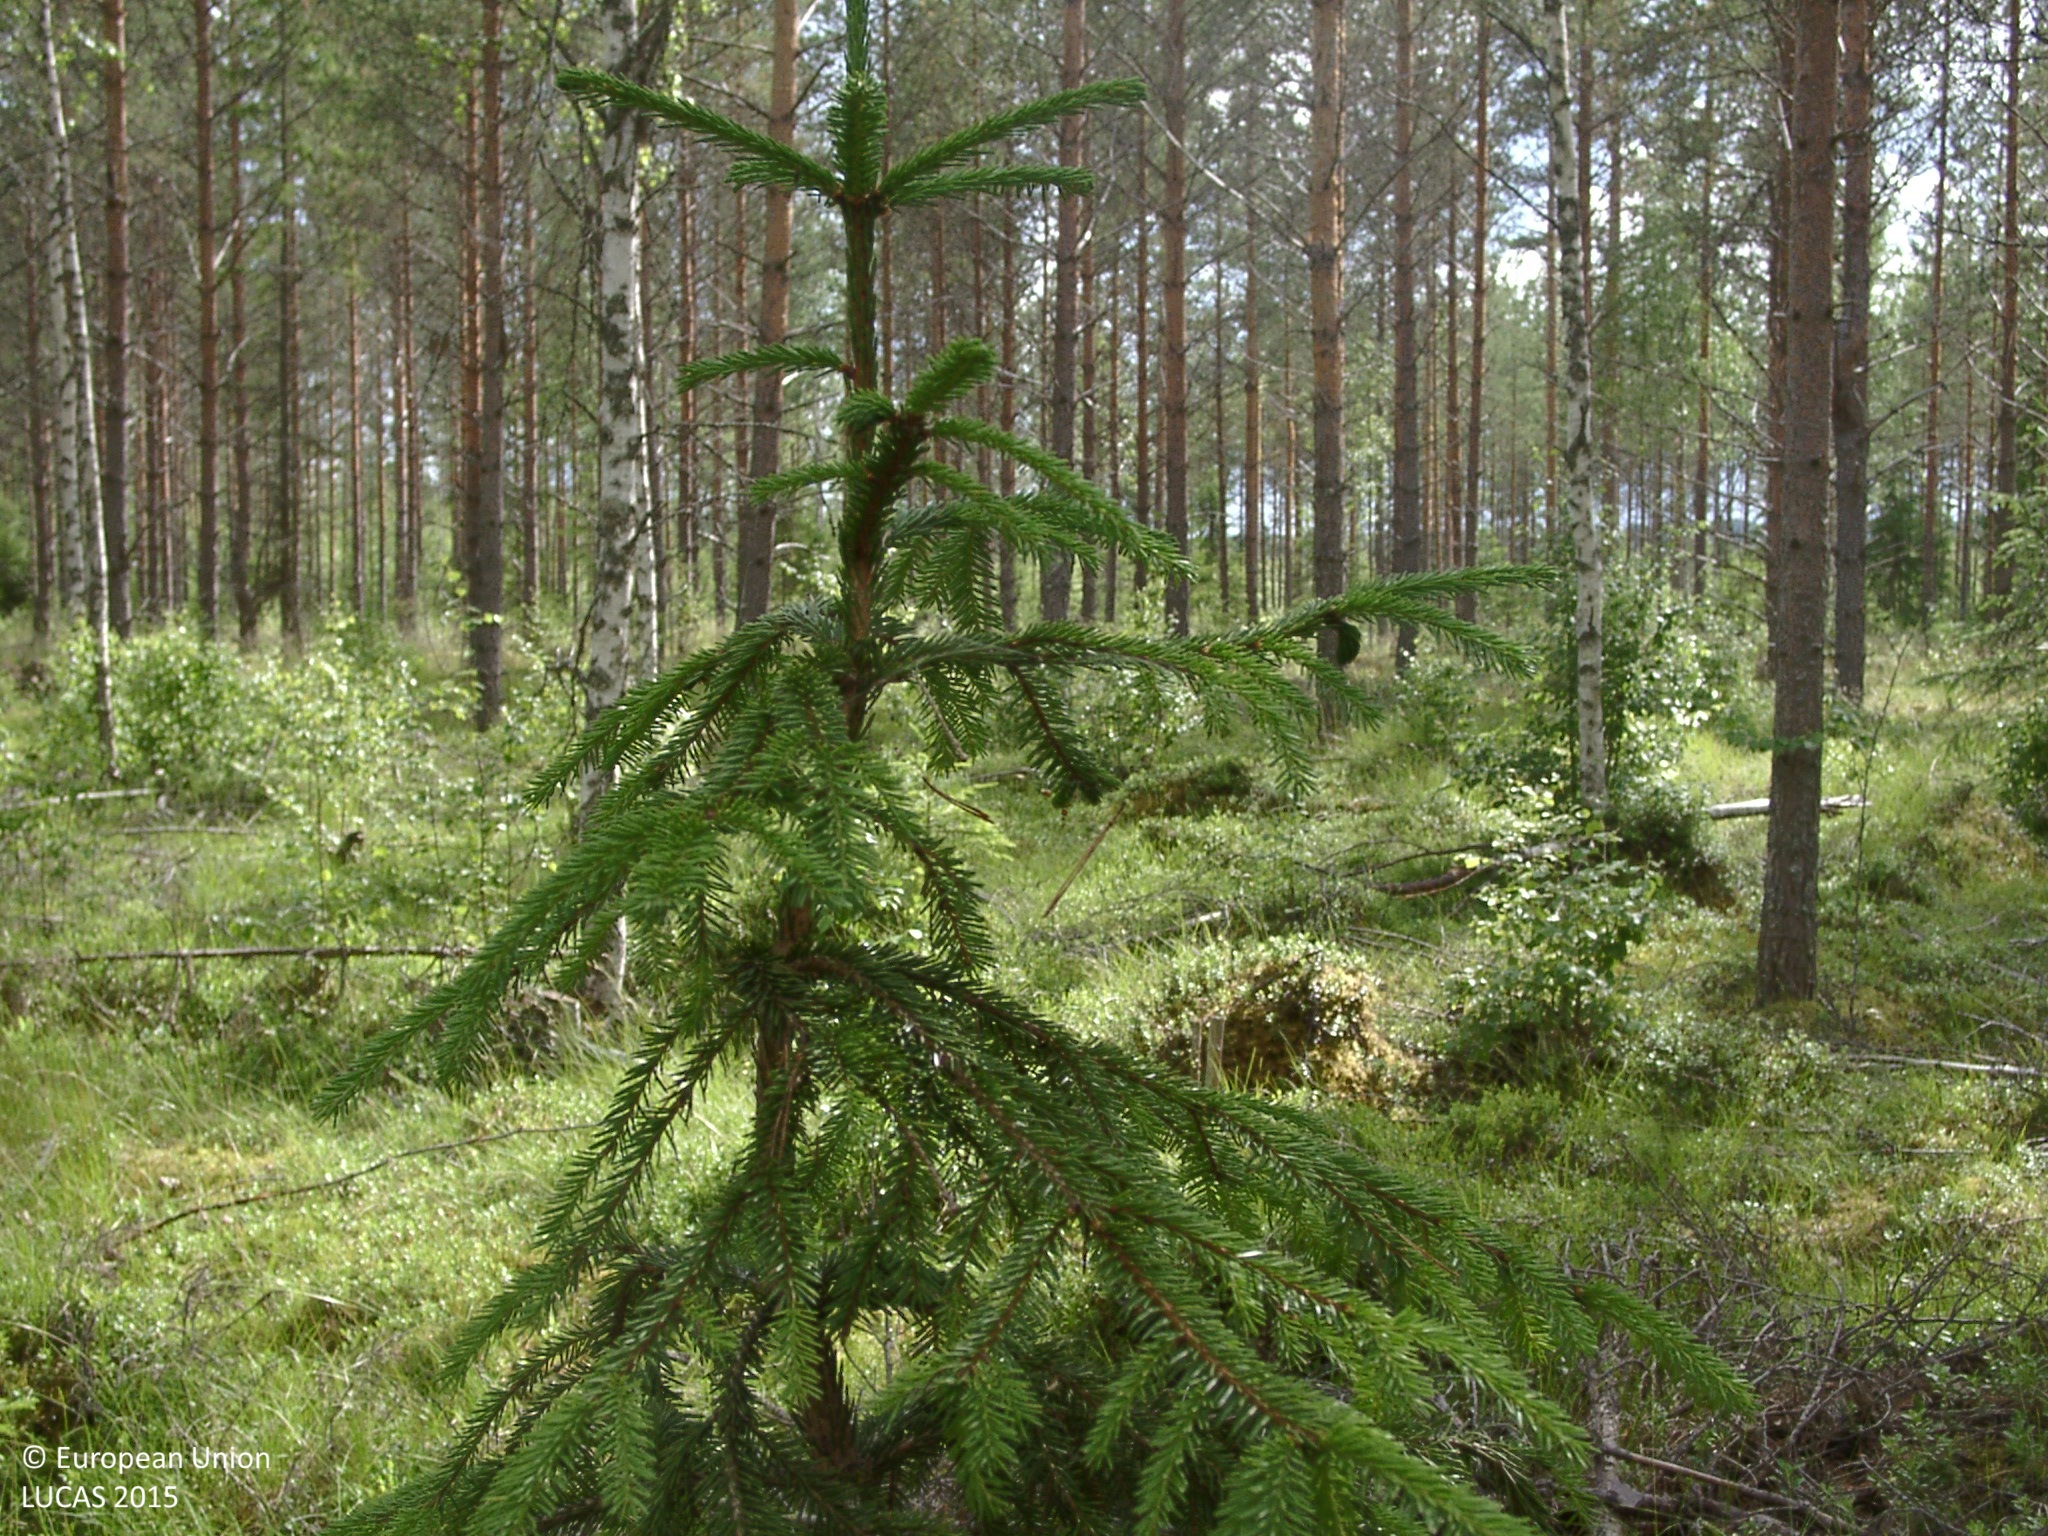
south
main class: Woodland
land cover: Pine dominated mixed woodland
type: boreal forest
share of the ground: 50 - 75 %
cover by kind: coniferous forest trees 45 %, broadleaved forest trees 15 %, shrubs 15 %, herbaceous plants 10 %, lichens and mosses 10 %
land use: Forestry
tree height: > 5 m
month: July
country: FI
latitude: 62.1678
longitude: 25.1790
